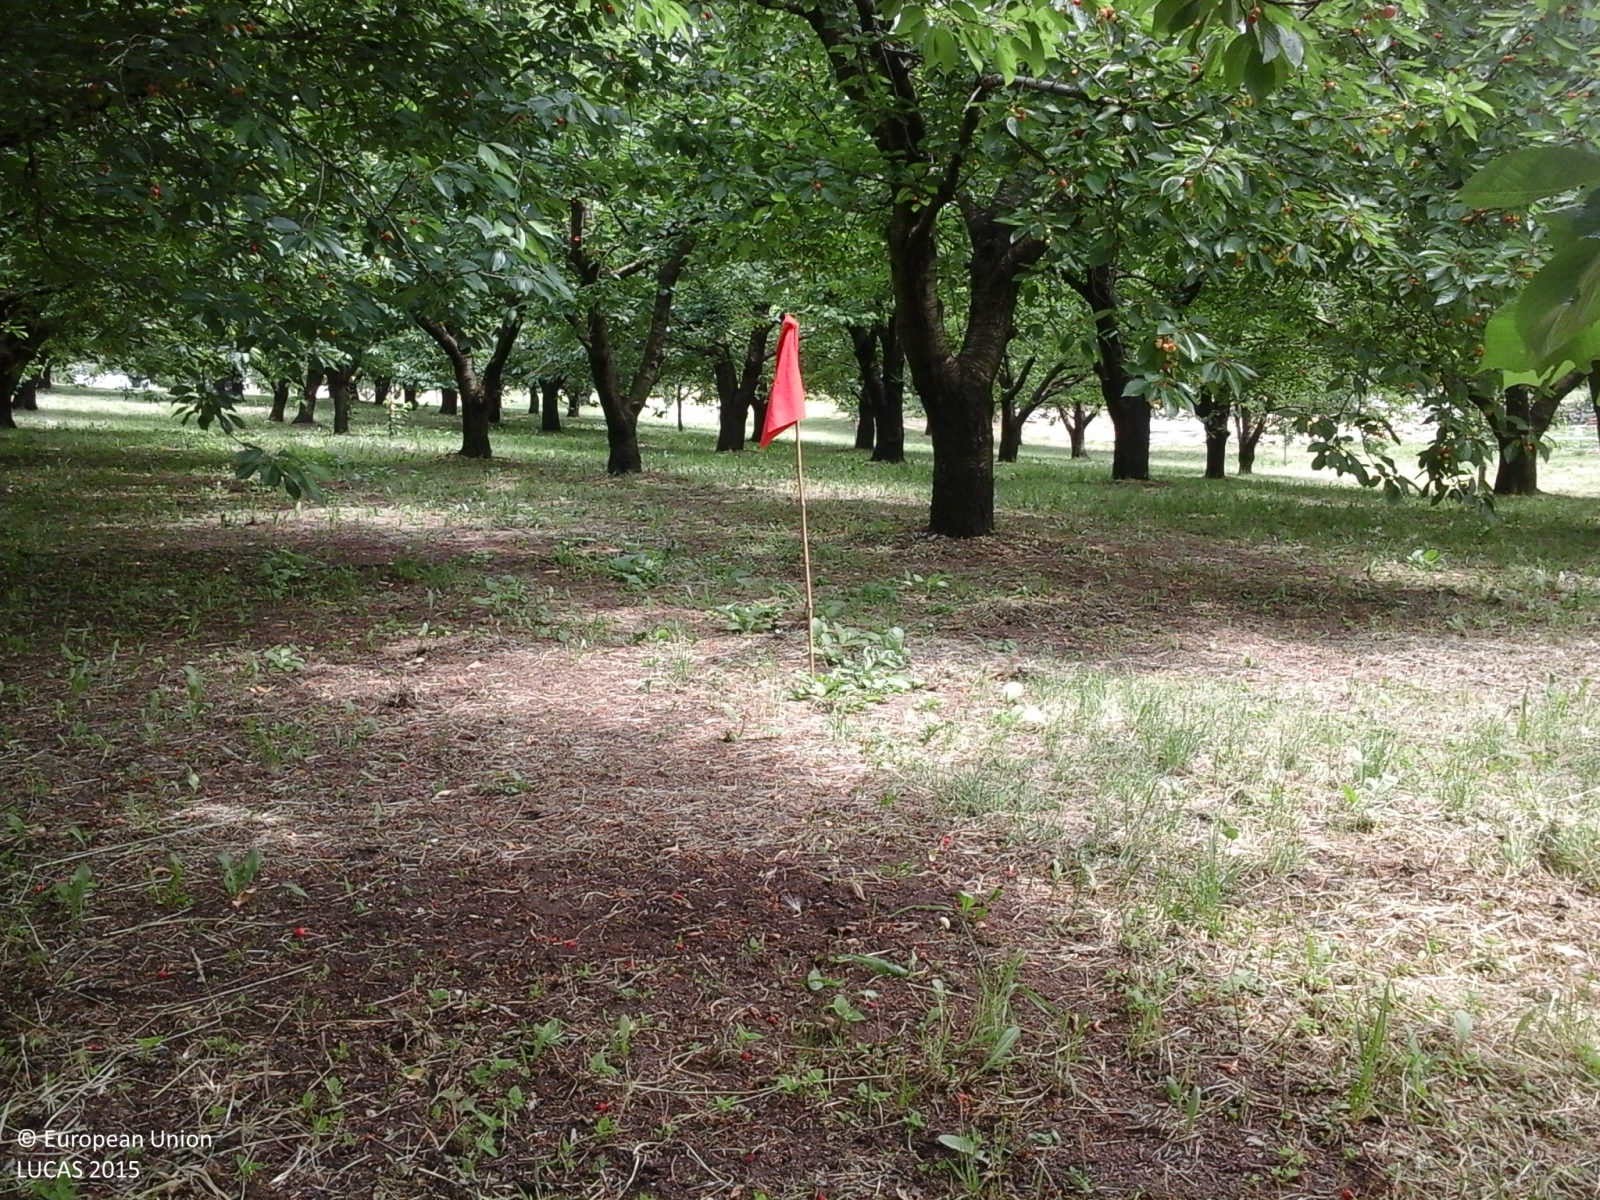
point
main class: Cropland
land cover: Cherry fruit
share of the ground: > 75 %
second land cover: Grassland without tree/shrub cover
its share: > 75 %
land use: Agriculture (excluding fallow land and kitchen gardens)
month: June
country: IT
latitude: 45.5724
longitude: 10.9339
